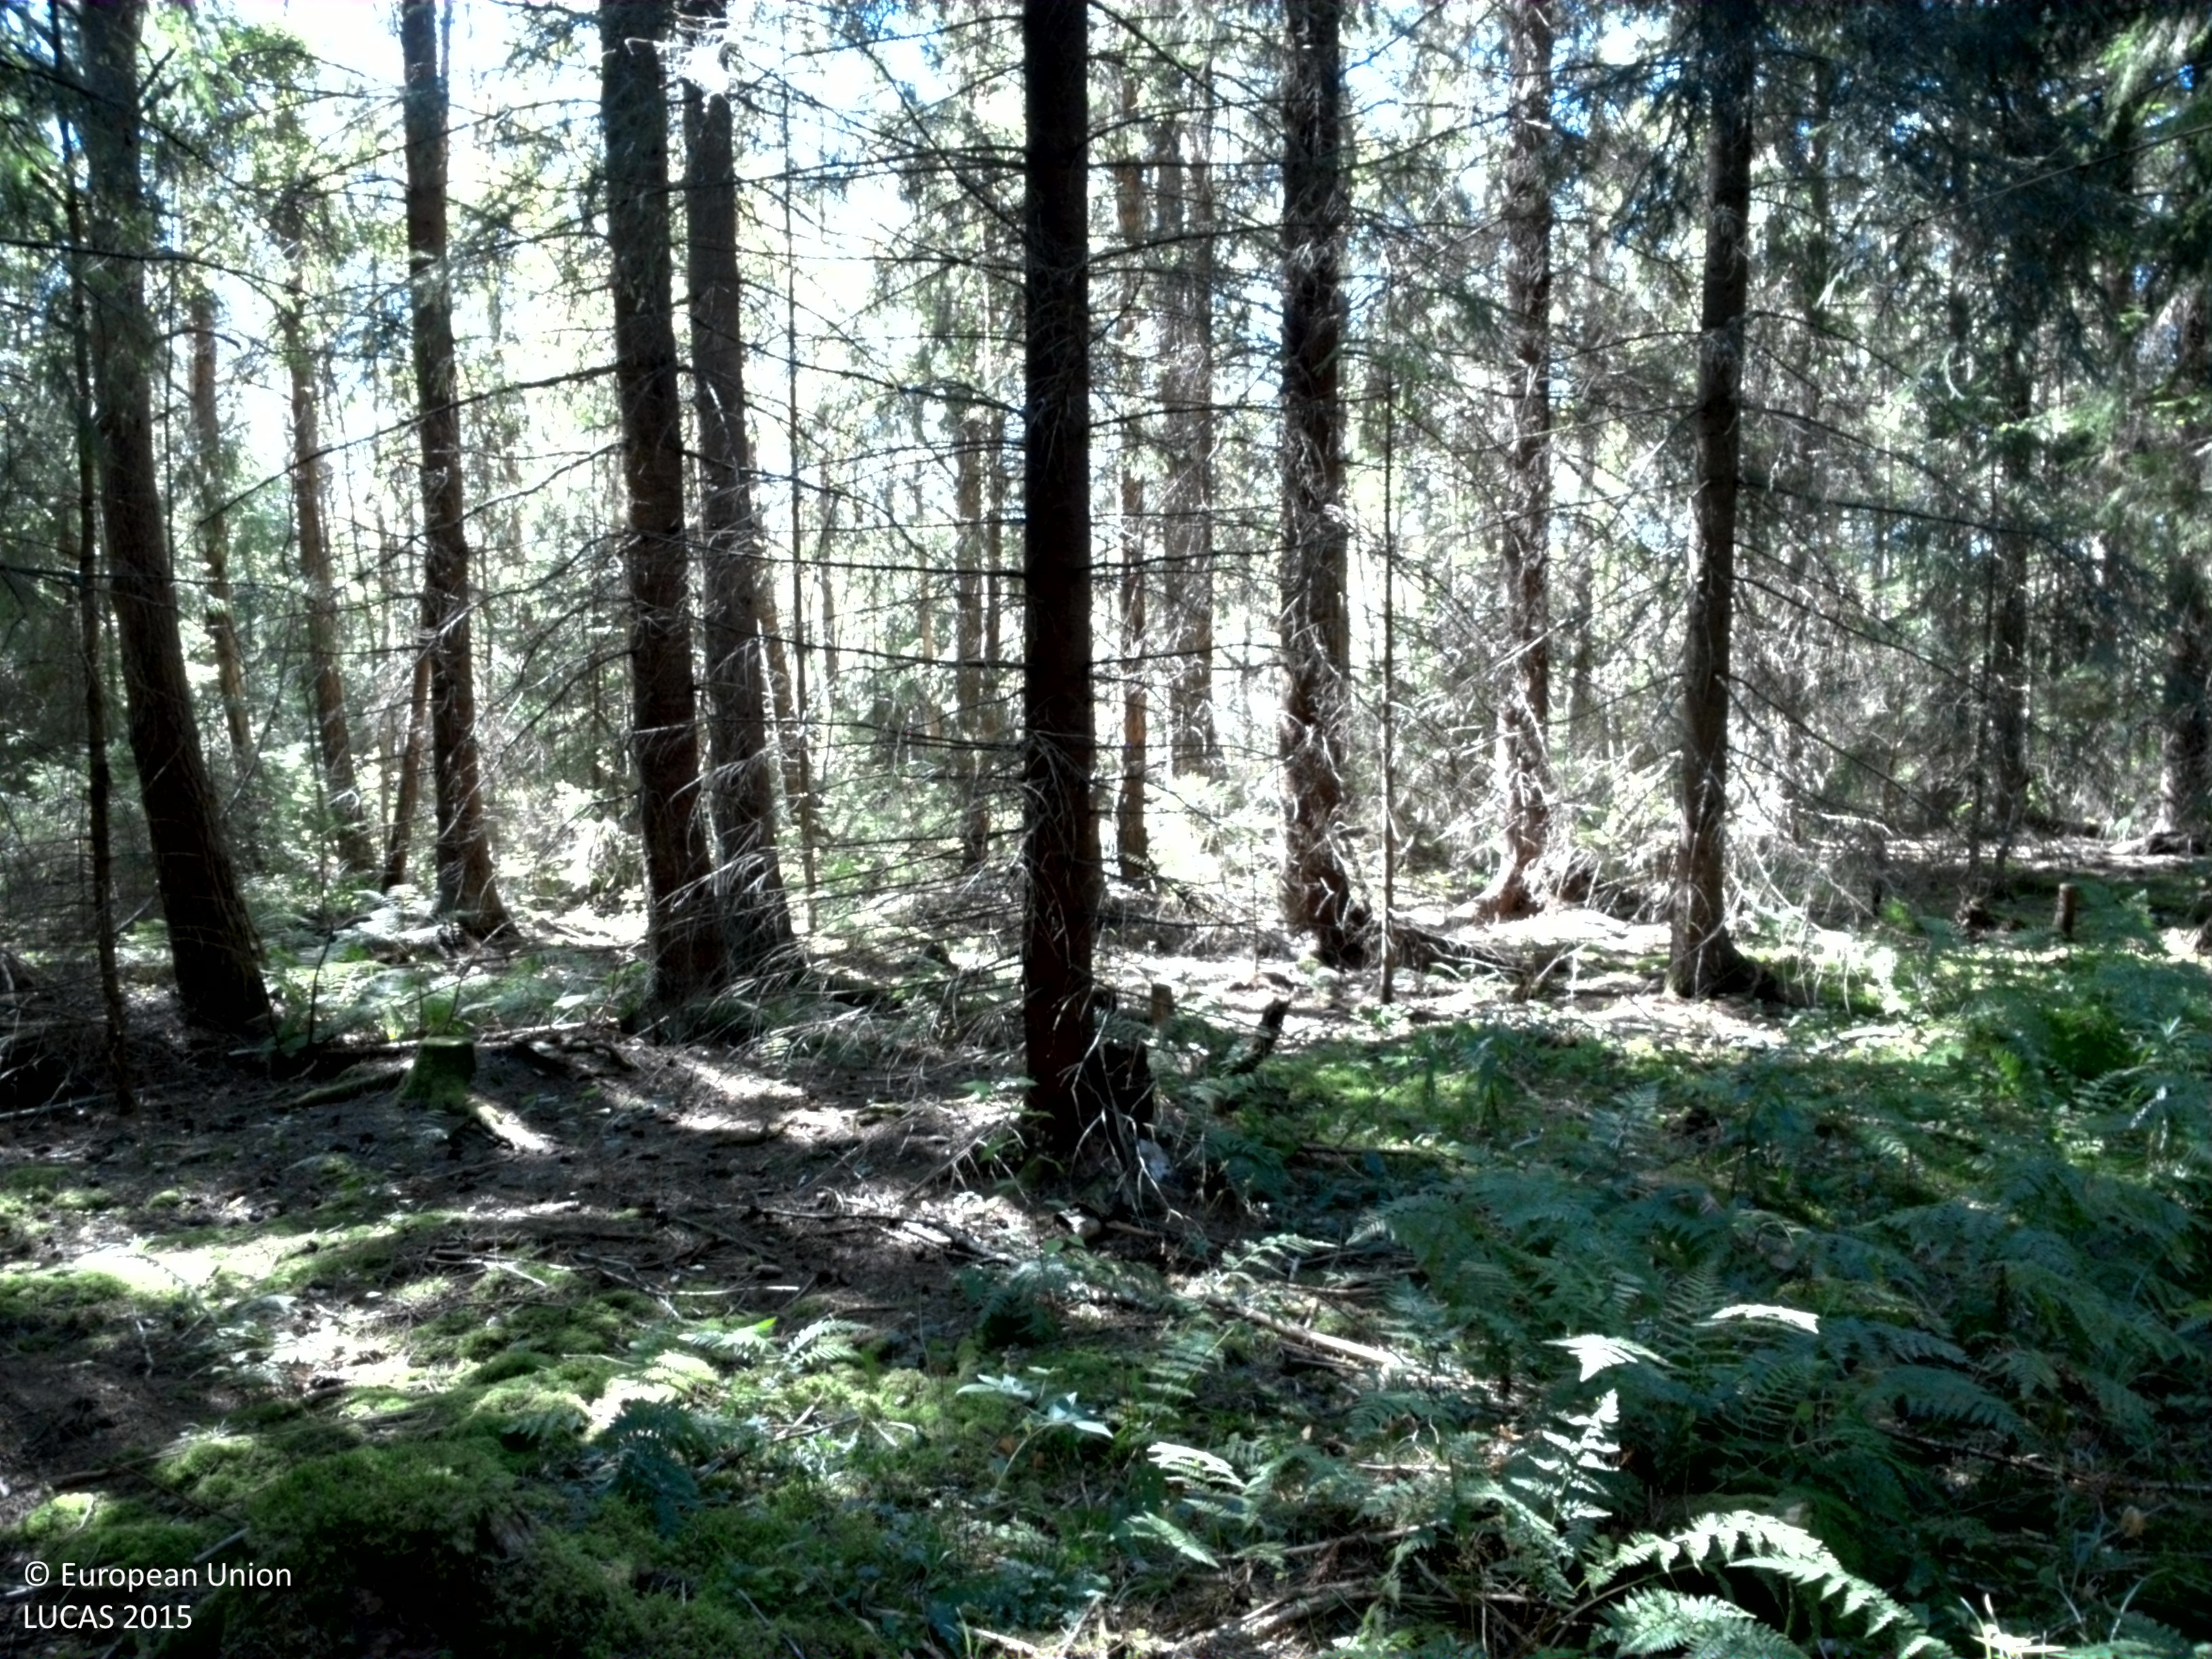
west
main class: Woodland
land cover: Spruce dominated coniferous woodland
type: boreal forest
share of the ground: > 75 %
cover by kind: coniferous forest trees 80 %, broadleaved forest trees 5 %, herbaceous plants 5 %, lichens and mosses 5 %, unconsolidated bare surface 5 %
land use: Forestry
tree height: > 5 m
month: August
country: SE
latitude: 59.9753
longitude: 17.9322
